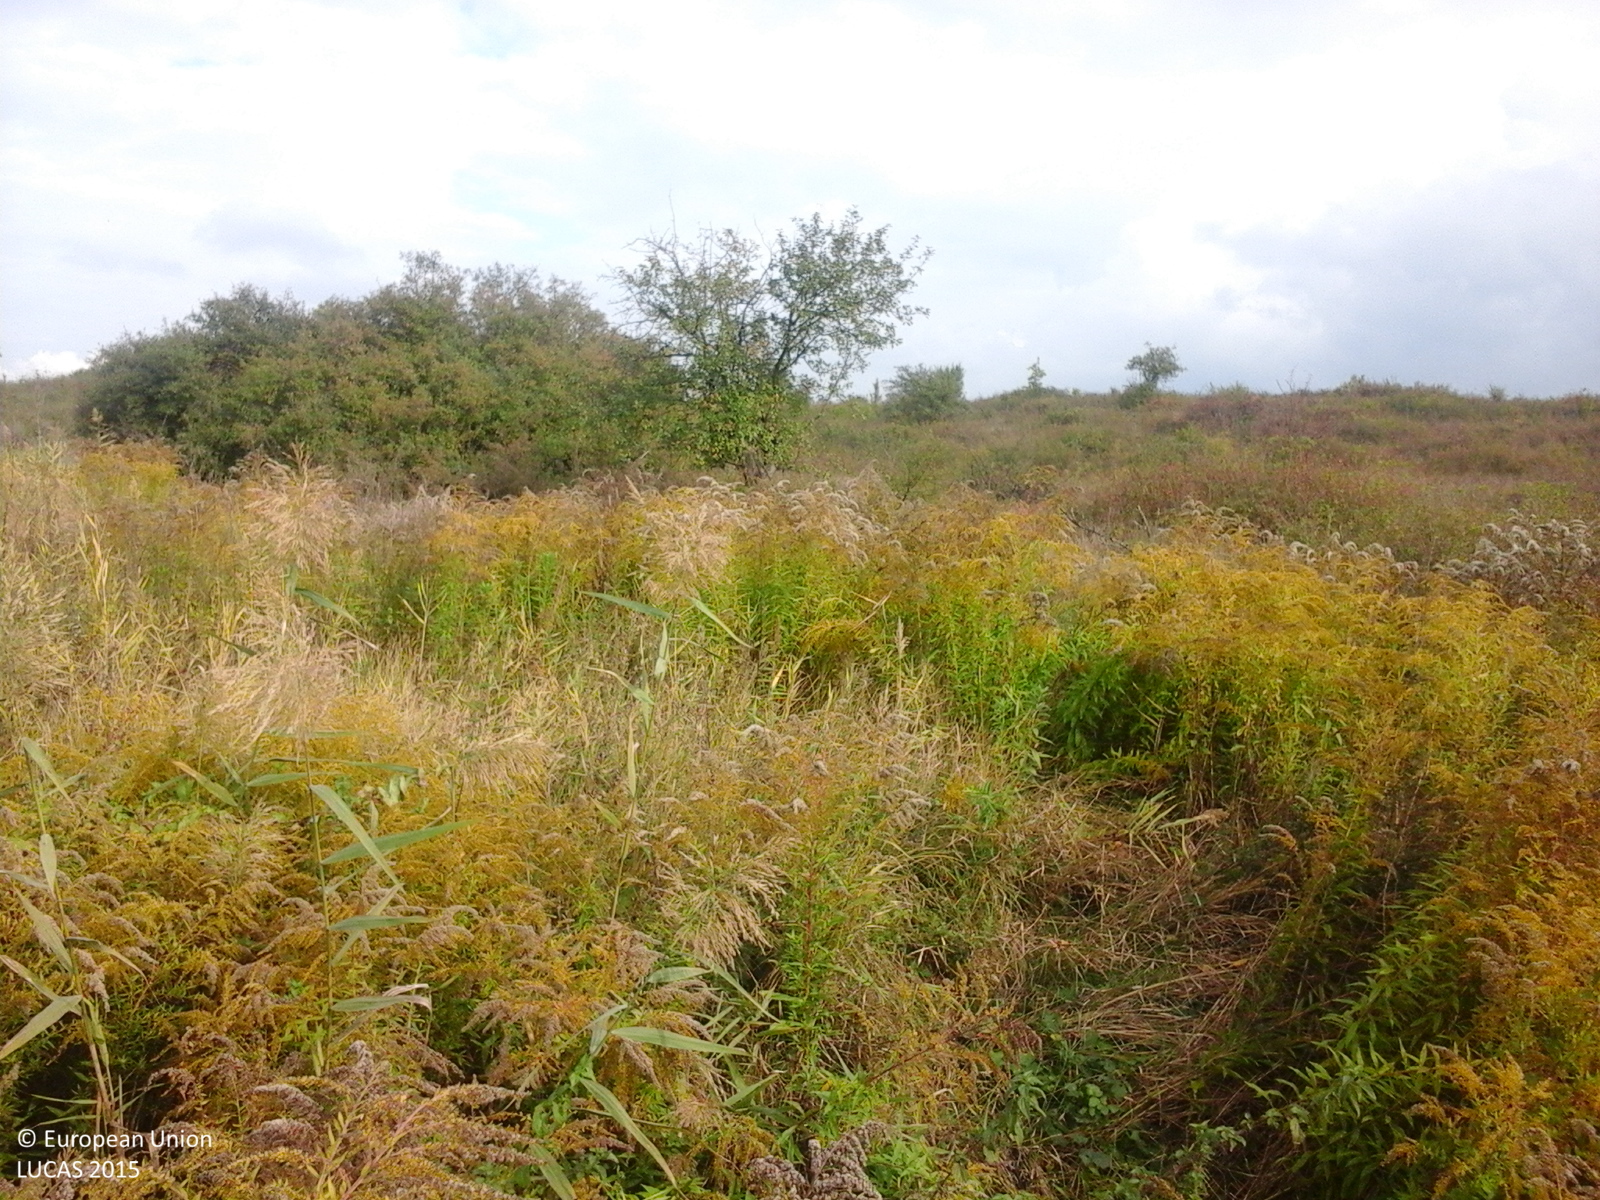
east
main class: Grassland
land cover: Spontaneously vegetated surfaces
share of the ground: > 75 %
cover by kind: herbaceous plants 100 %
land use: Fallow land
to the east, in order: Spontaneously vegetated surfaces; Tracks; Grassland with sparse tree/shrub cover; Single bushes/trees; Shrubland with sparse tree cover; Maize
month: October
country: RO
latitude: 46.2105
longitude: 24.2732
